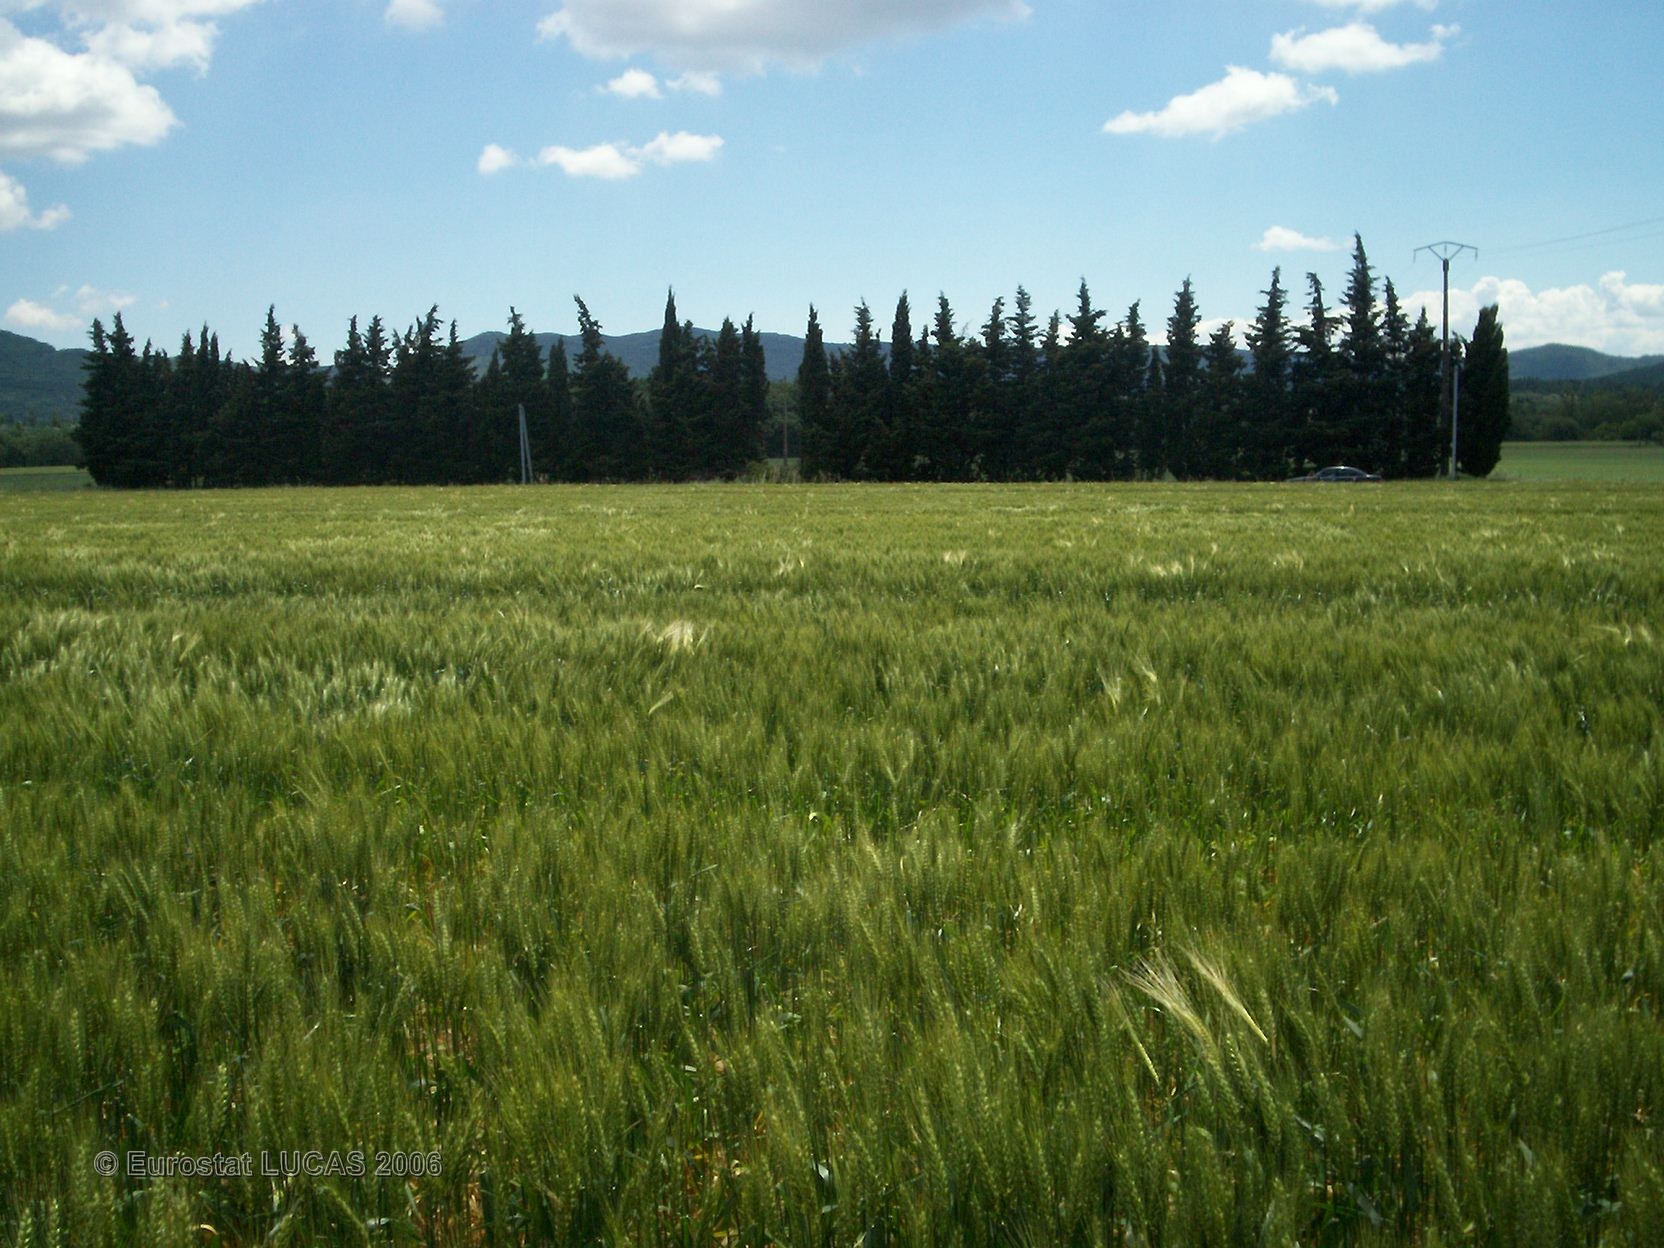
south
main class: Cropland
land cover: Durum wheat
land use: Agriculture (excluding fallow land and kitchen gardens)
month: May
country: FR
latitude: 44.5508
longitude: 4.9087
